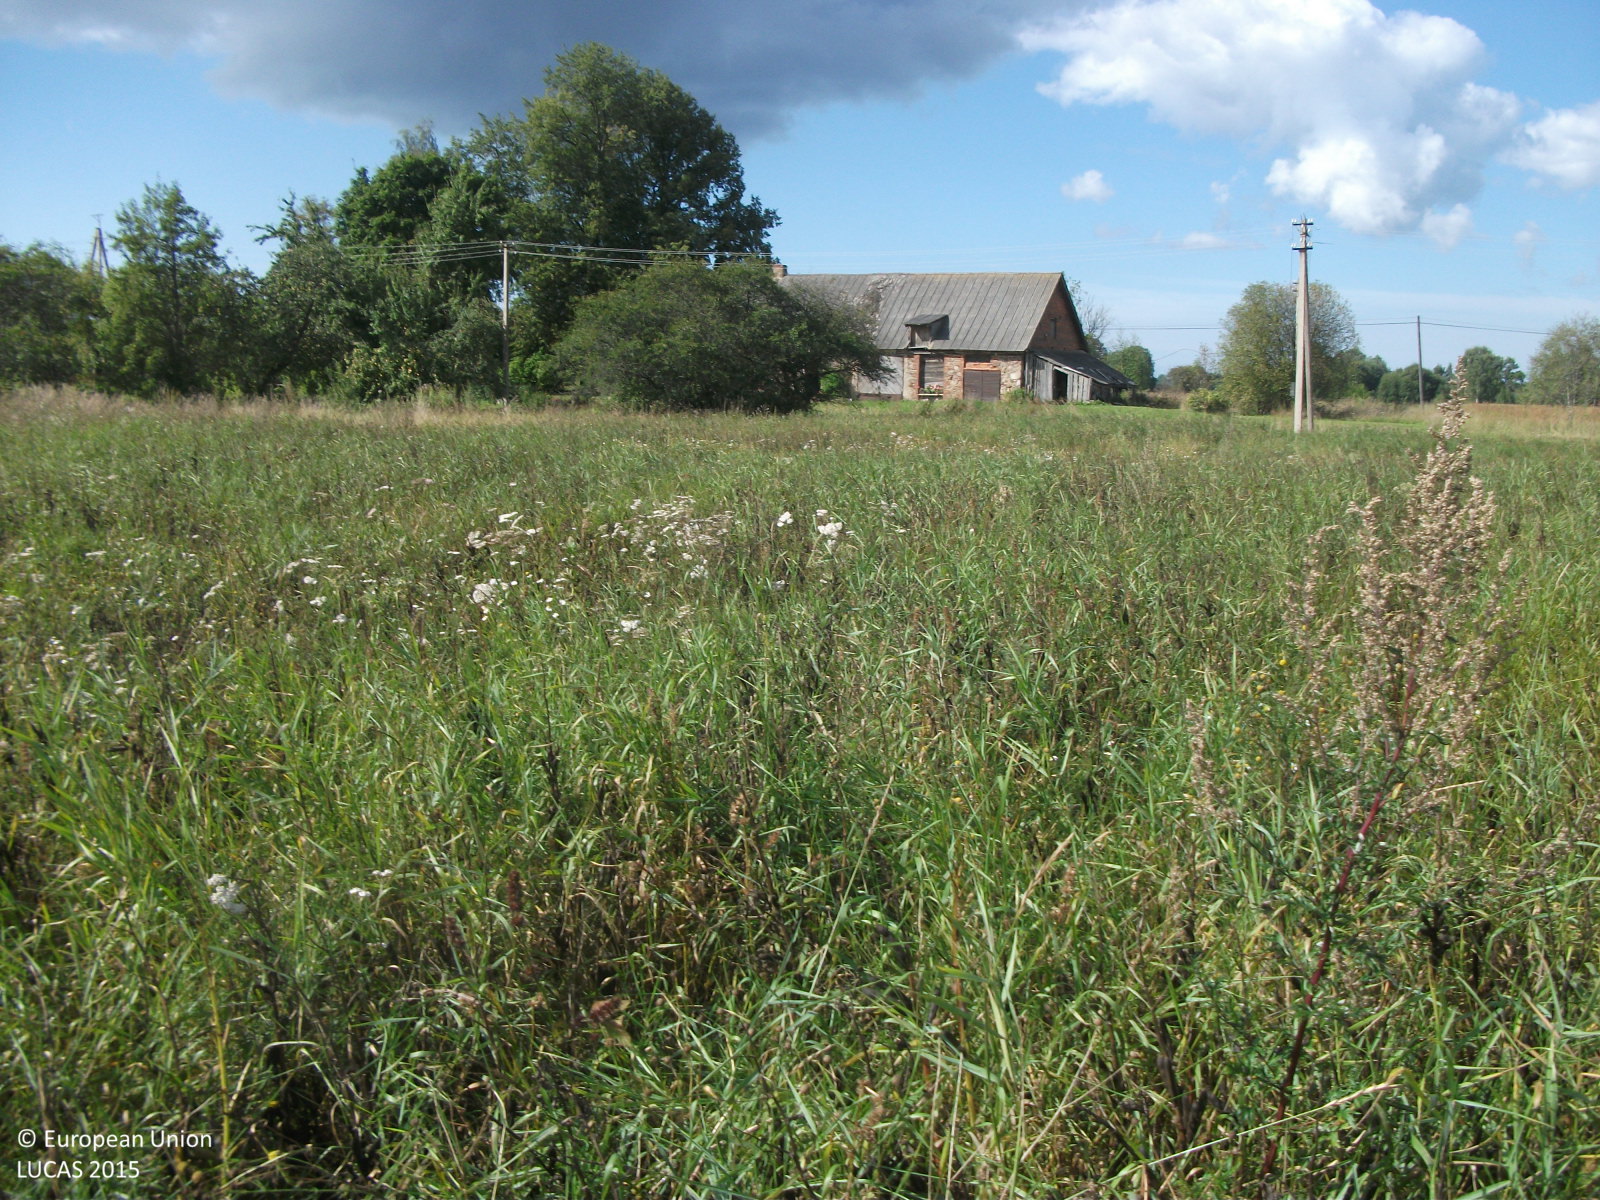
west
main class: Cropland
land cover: Dry pulses
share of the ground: > 75 %
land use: Agriculture (excluding fallow land and kitchen gardens)
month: September
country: LV
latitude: 57.4837
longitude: 24.4854
